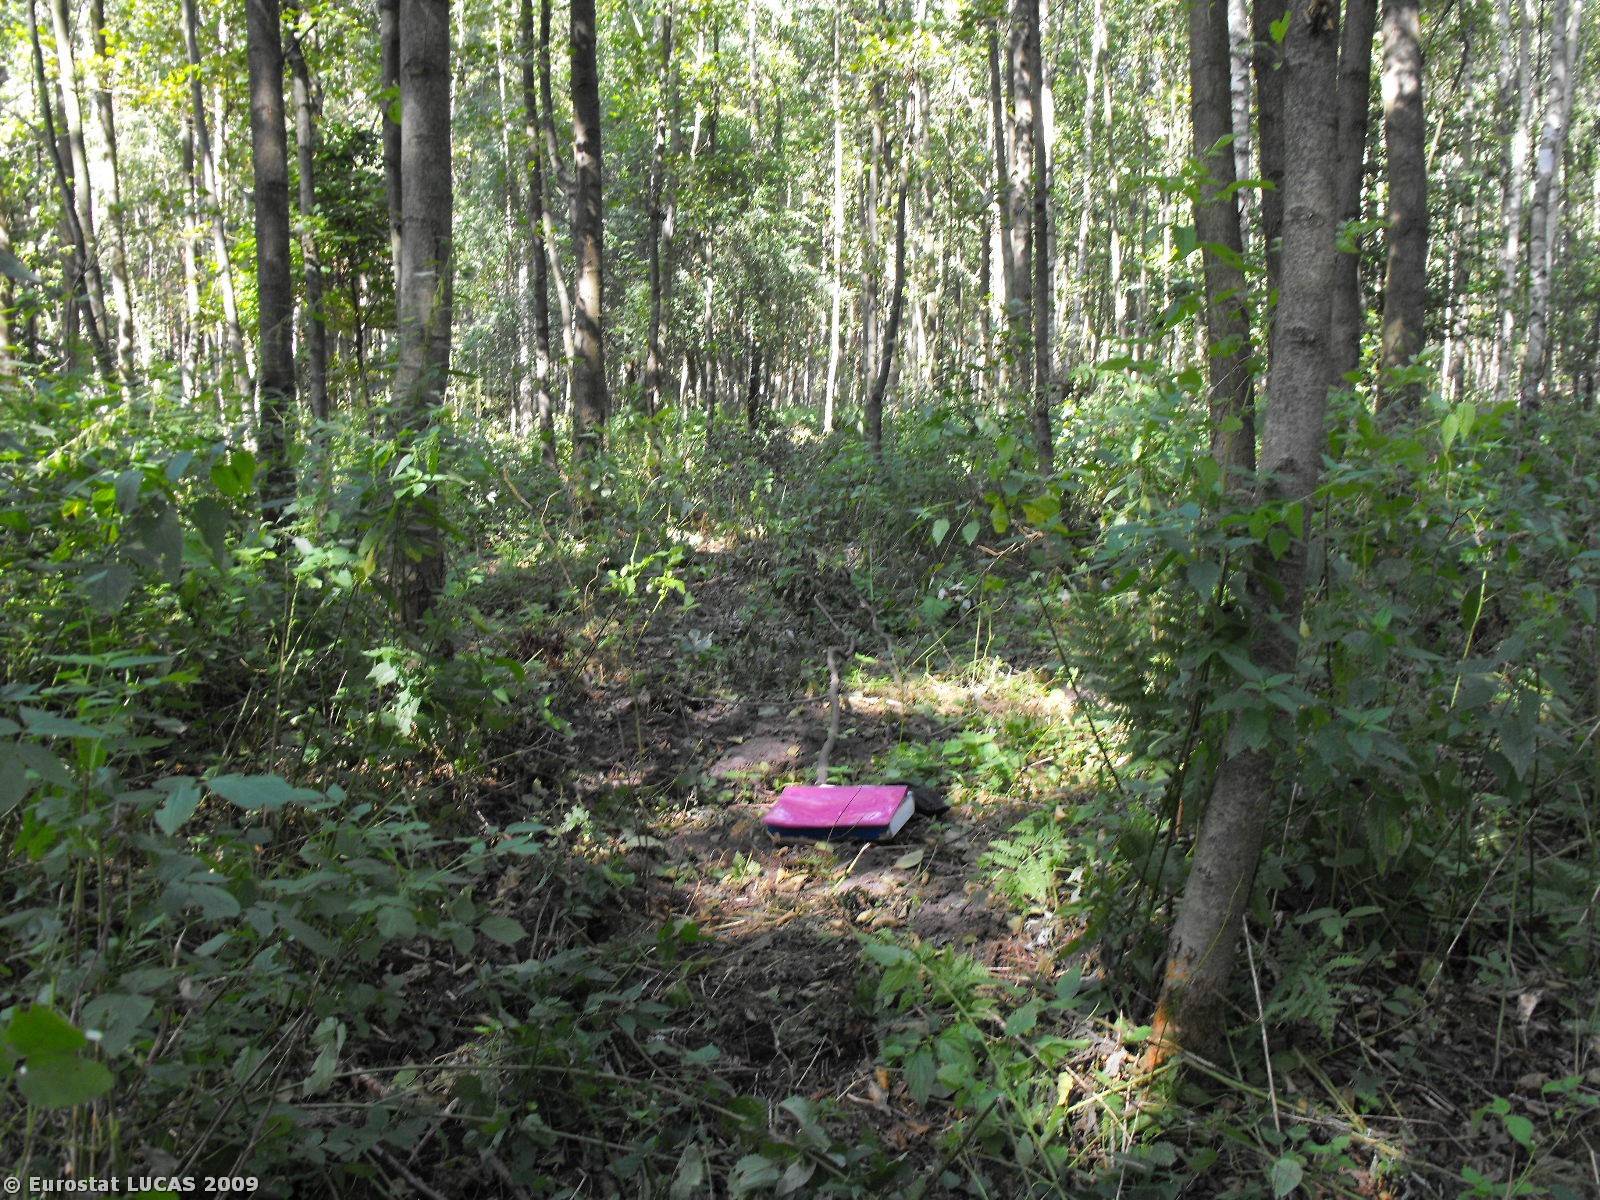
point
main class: Woodland
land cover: Broadleaved woodland
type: hemiboreal forest and nemoral coniferous forest and mixed broadleaved-coniferous forest
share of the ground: > 75 %
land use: Forestry
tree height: > 5 m
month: August
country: PL
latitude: 52.8130
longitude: 16.4908
